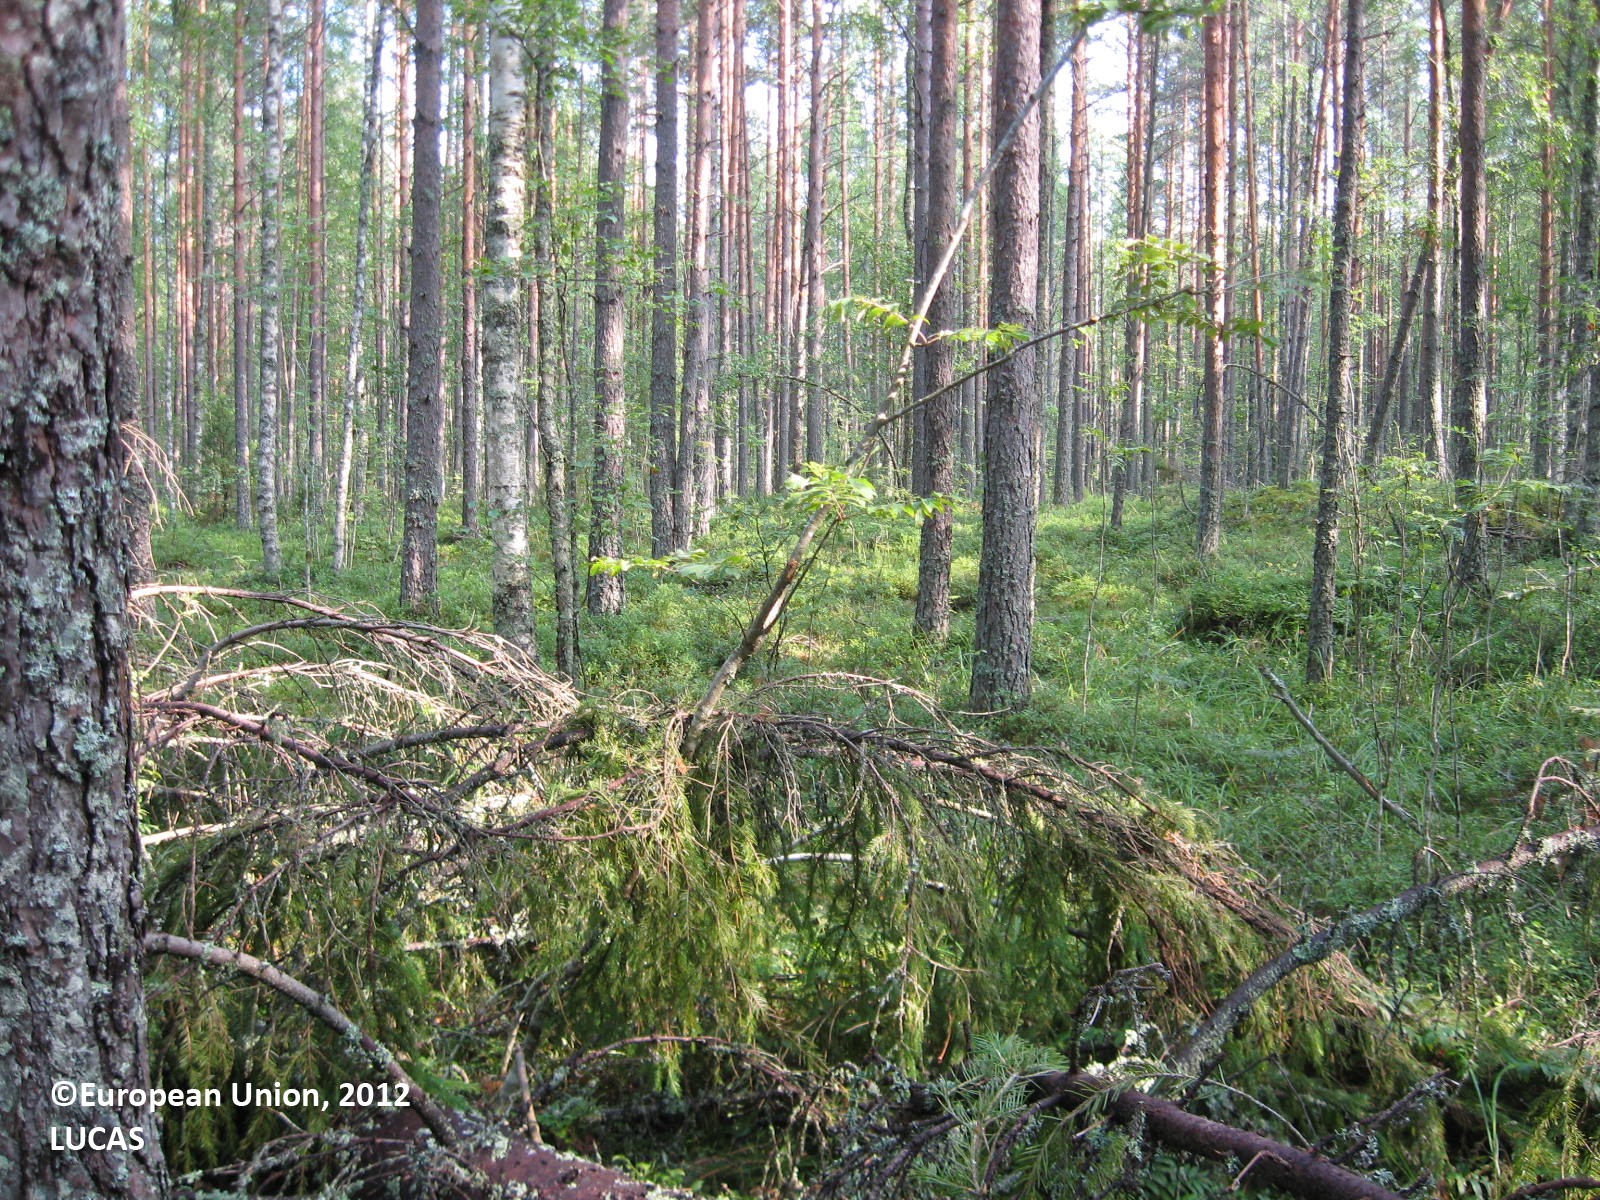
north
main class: Woodland
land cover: Pine dominated mixed woodland
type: boreal forest
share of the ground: > 75 %
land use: Forestry
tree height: > 5 m
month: July
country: FI
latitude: 61.8936
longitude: 22.2151
